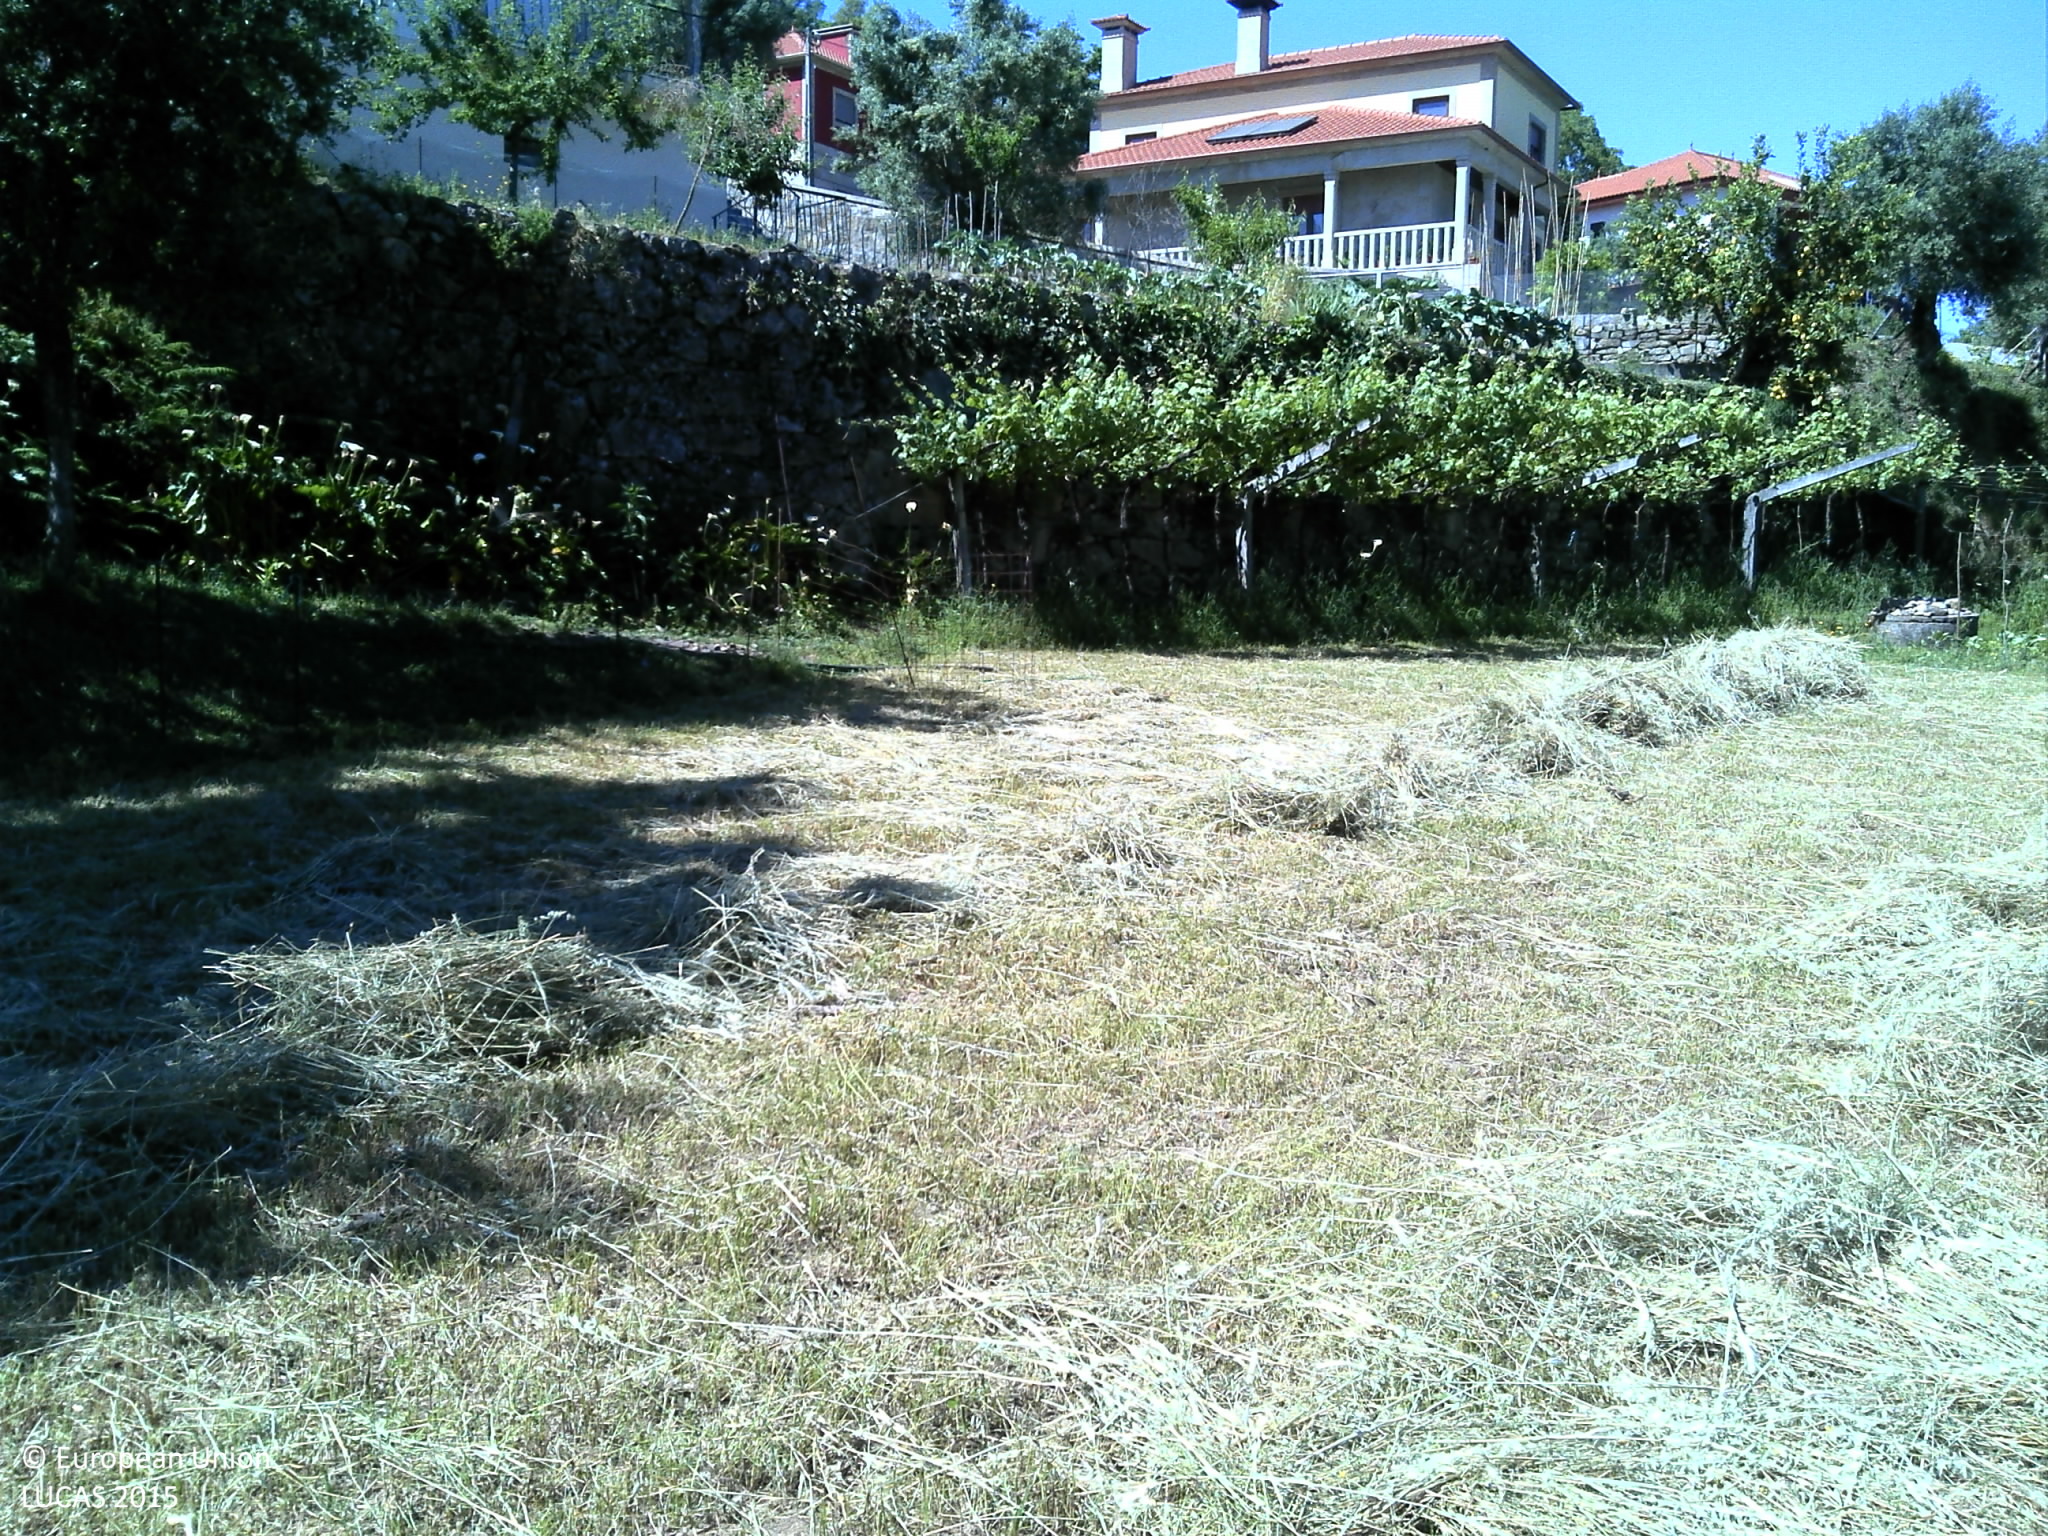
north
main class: Cropland
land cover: Temporary grasslands
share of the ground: 25 - 50 %
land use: Agriculture (excluding fallow land and kitchen gardens)
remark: Harvested field
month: May
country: PT
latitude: 41.6932
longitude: -8.5802
